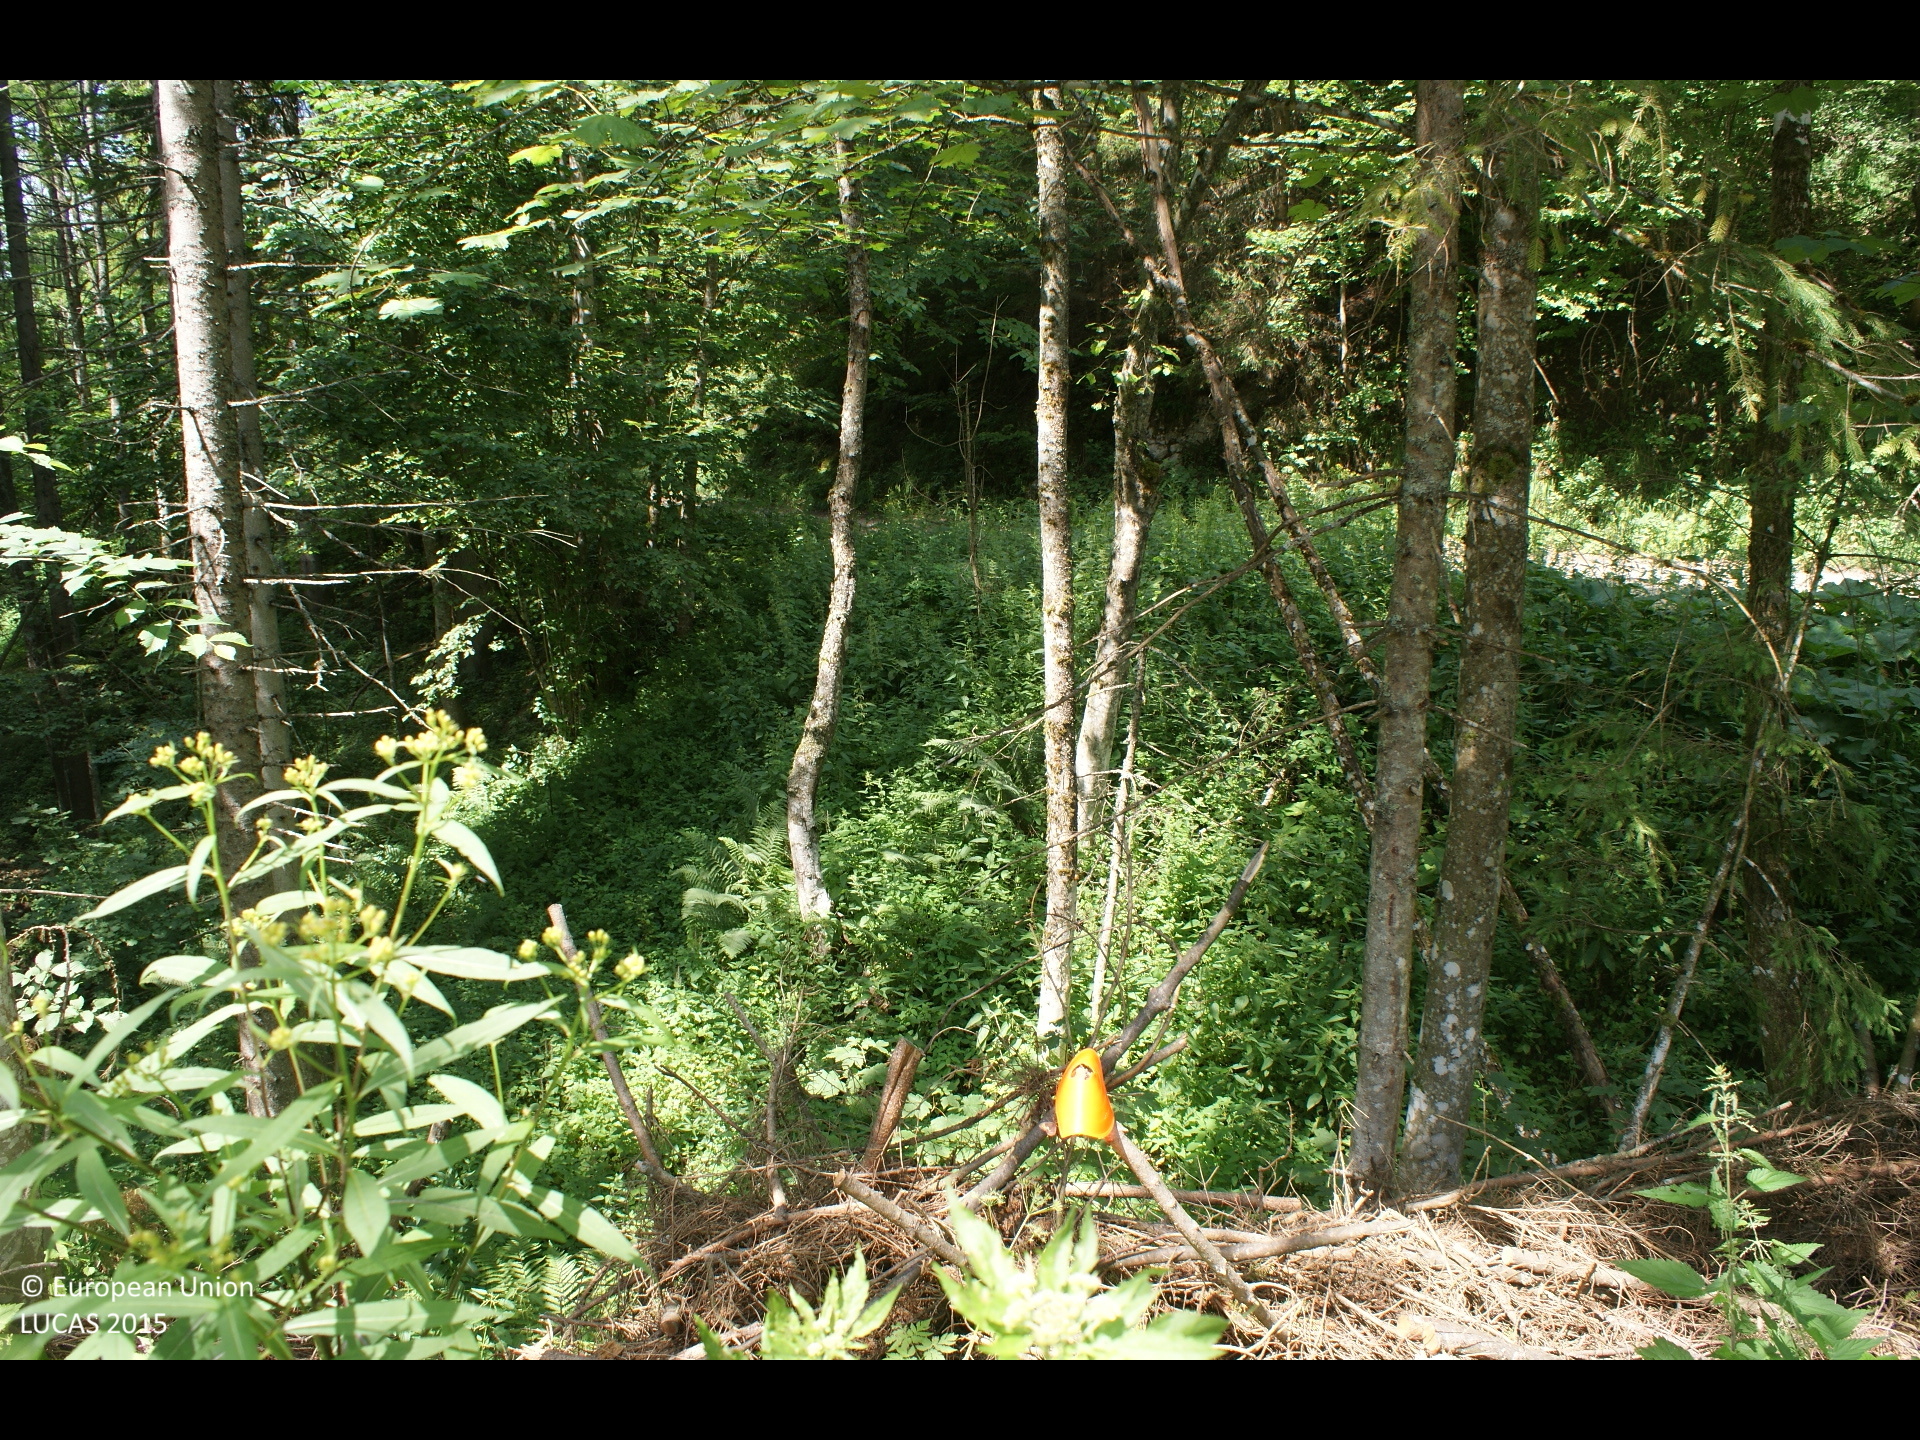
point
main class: Woodland
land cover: Spruce dominated mixed woodland
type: mesophytic deciduous forest
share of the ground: > 75 %
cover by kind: coniferous forest trees 55 %, broadleaved forest trees 30 %, herbaceous plants 10 %, shrubs 5 %
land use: Forestry
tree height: > 5 m
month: July
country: AT
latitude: 47.8600
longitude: 15.3345
